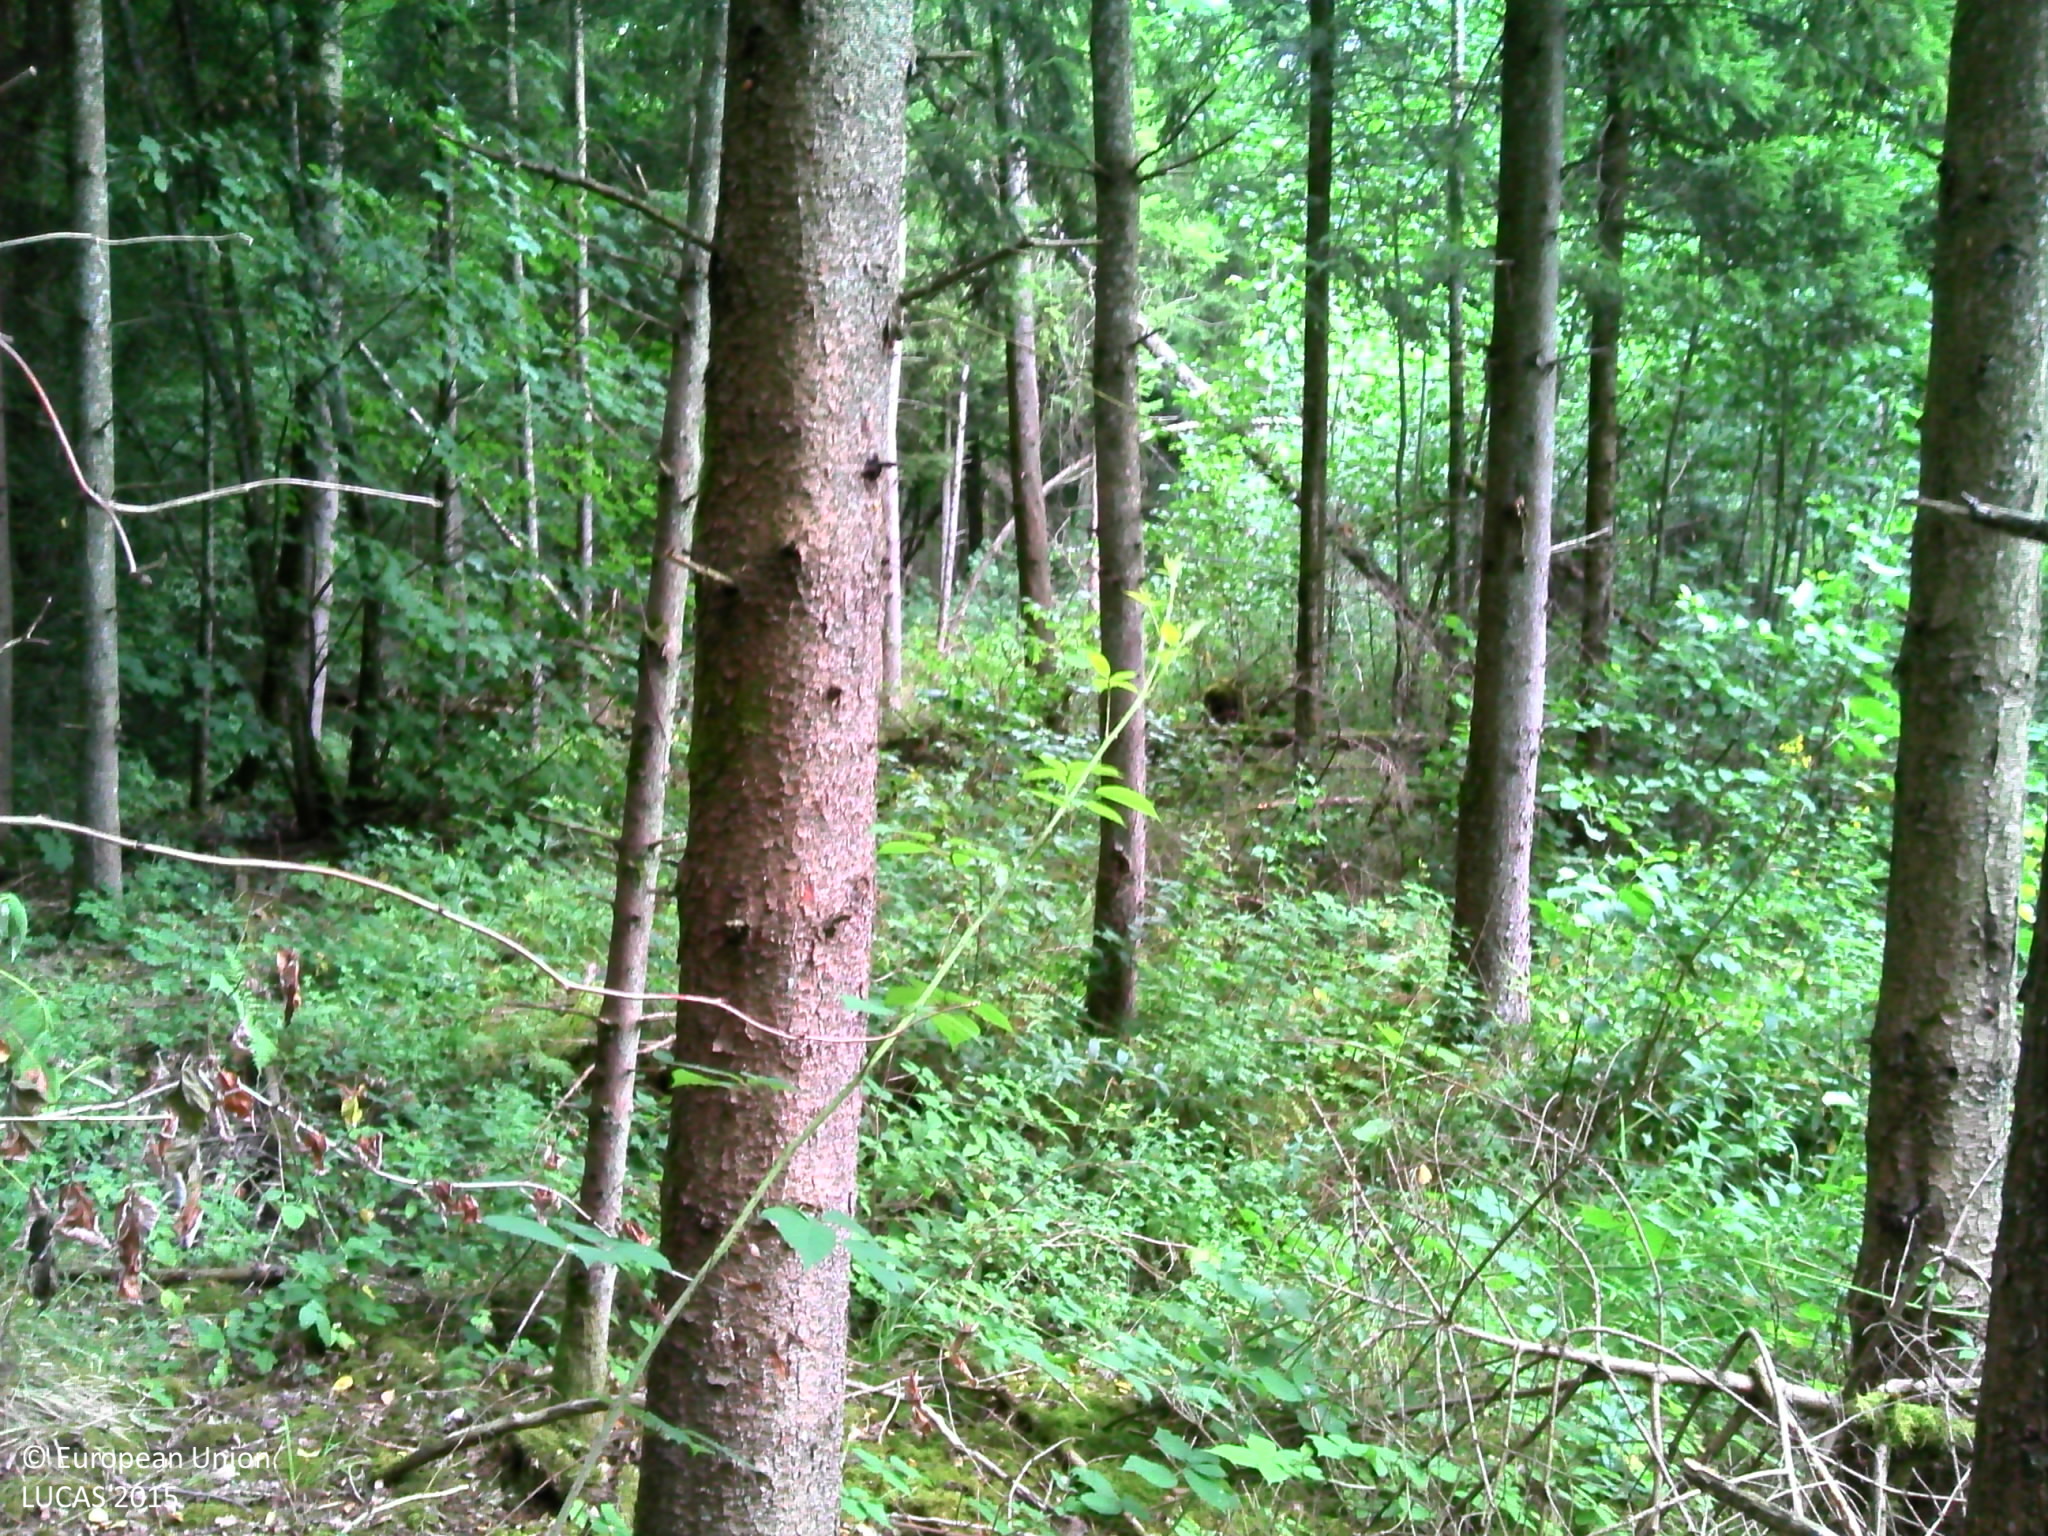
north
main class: Woodland
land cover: Spruce dominated coniferous woodland
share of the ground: 50 - 75 %
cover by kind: coniferous forest trees 60 %, shrubs 25 %, herbaceous plants 10 %, broadleaved forest trees 5 %
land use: Forestry
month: July
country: BE
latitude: 49.6875
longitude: 5.6602
